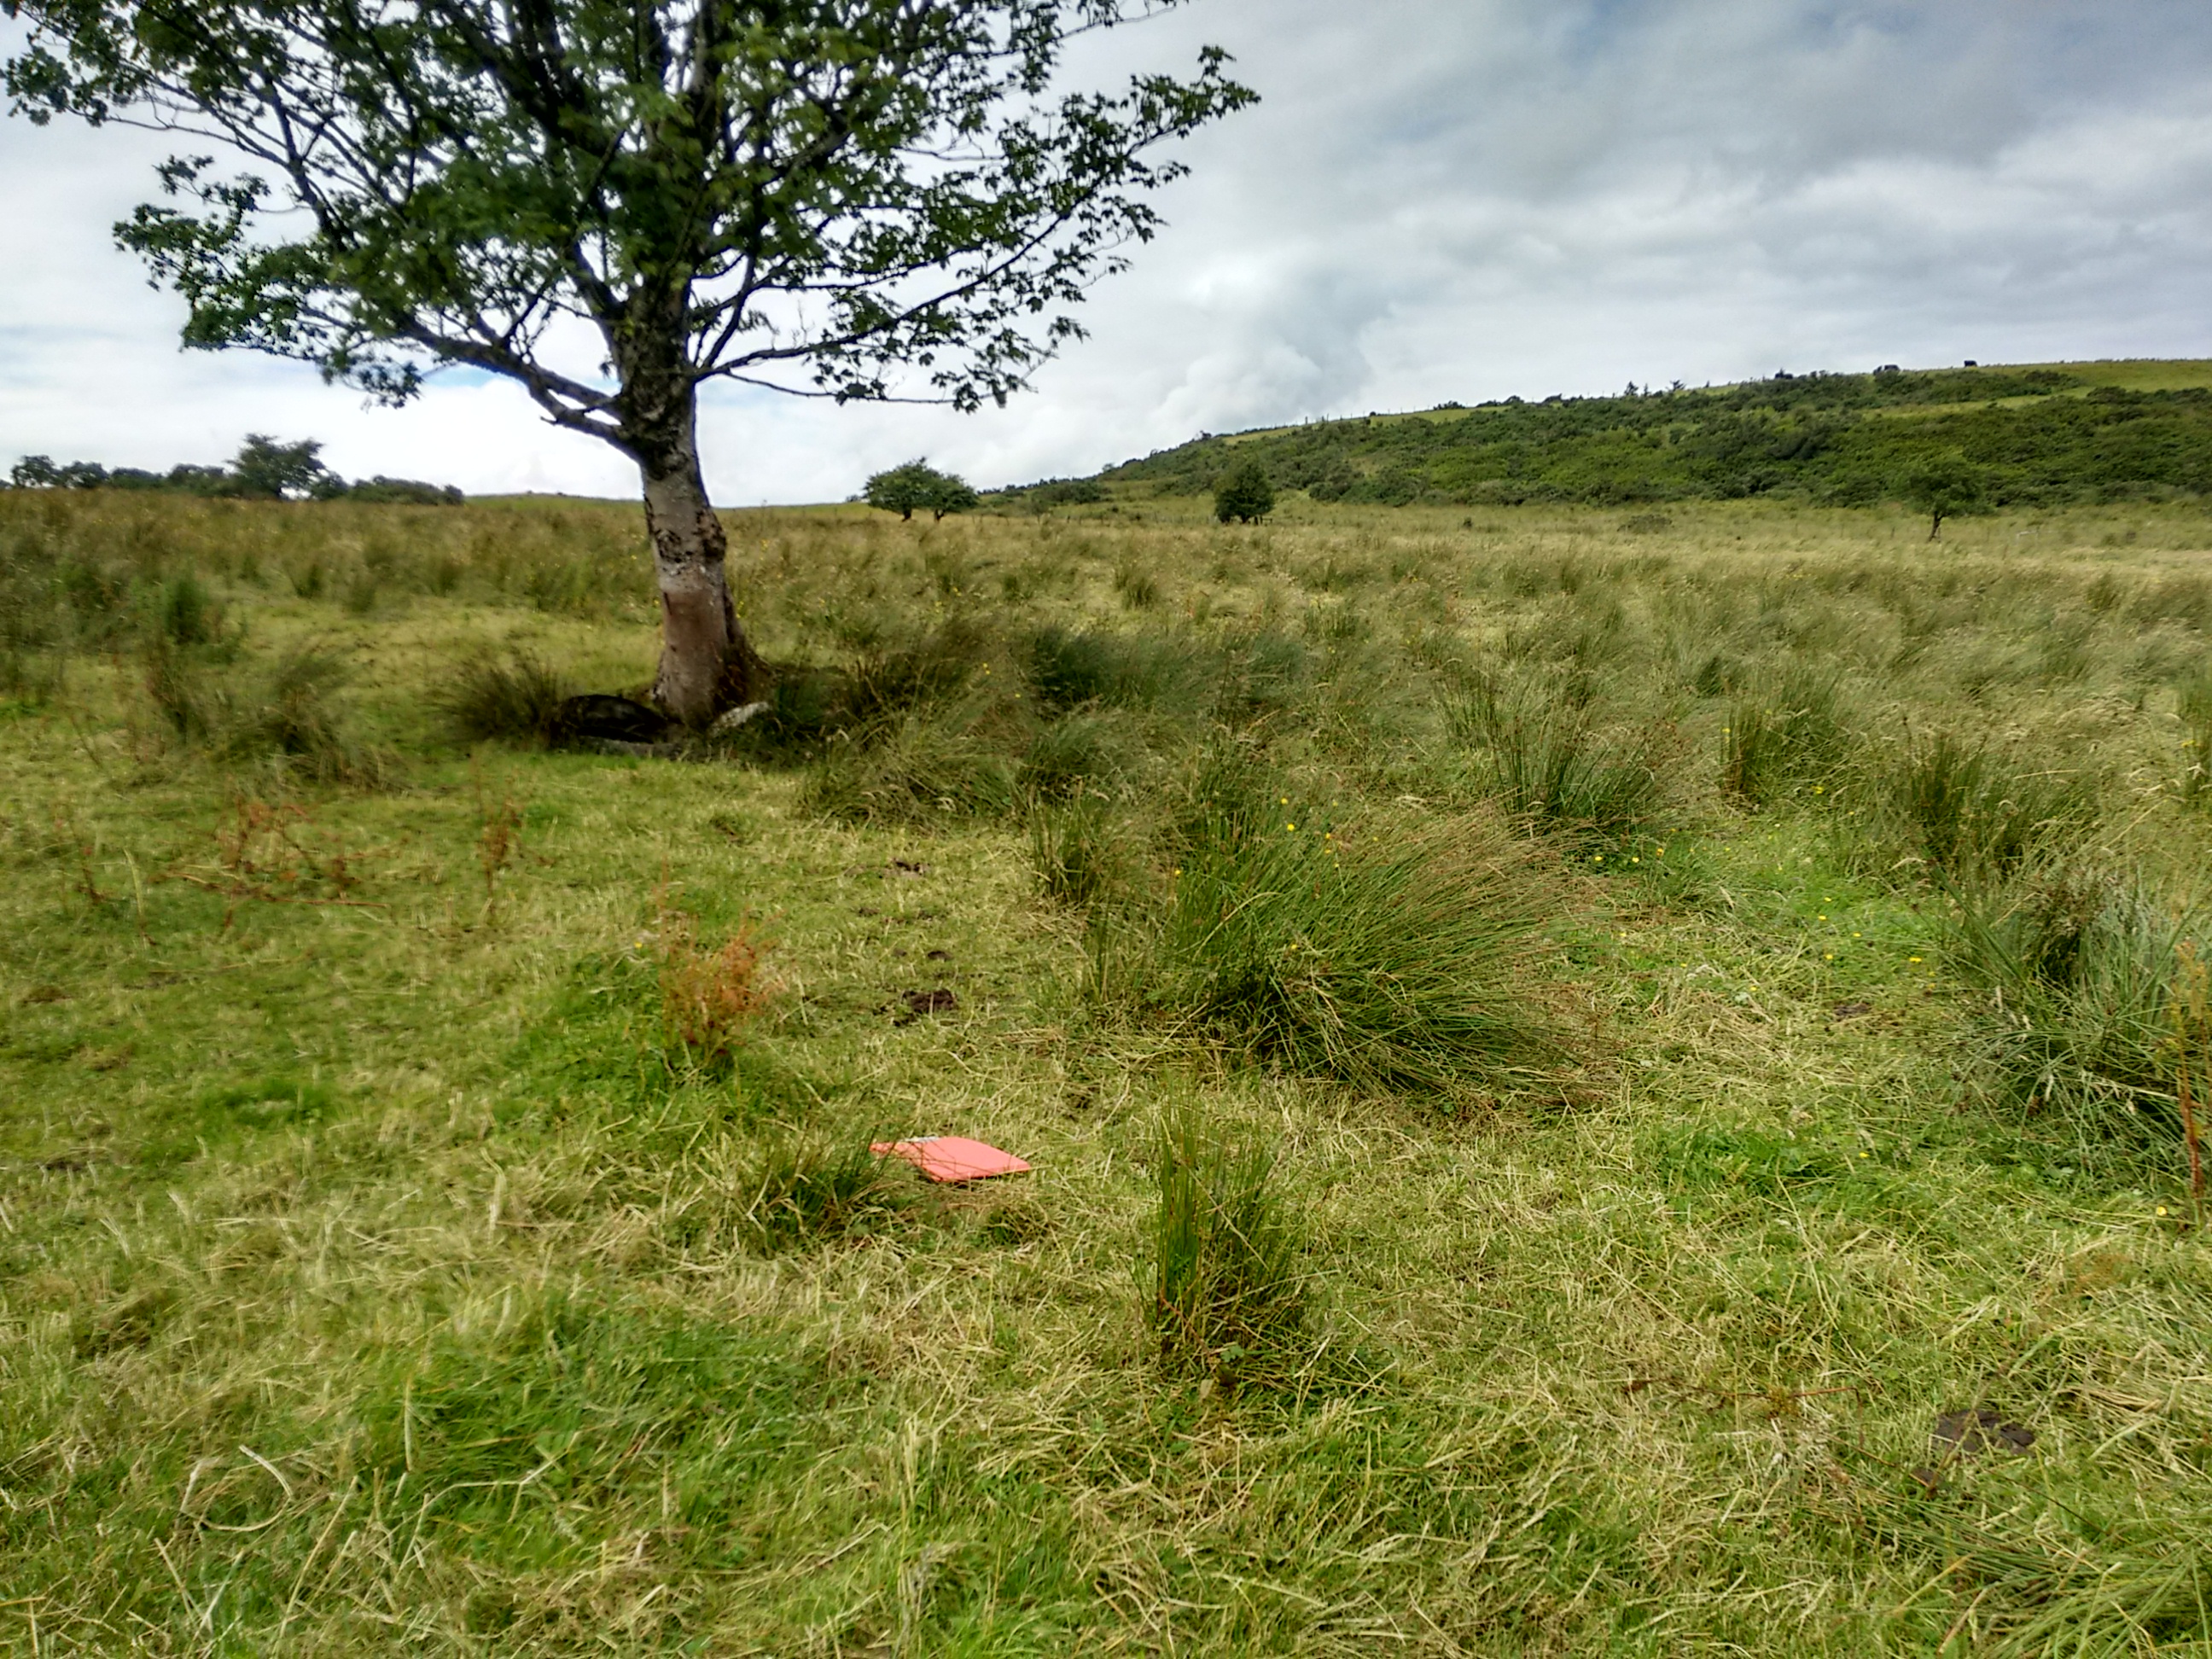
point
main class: Grassland
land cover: Grassland with sparse tree/shrub cover
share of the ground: > 75 %
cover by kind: herbaceous plants 95 %, broadleaved forest trees 5 %
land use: Agriculture (excluding fallow land and kitchen gardens)
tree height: > 5 m
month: August
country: GB
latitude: 54.5335
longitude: -6.9360
